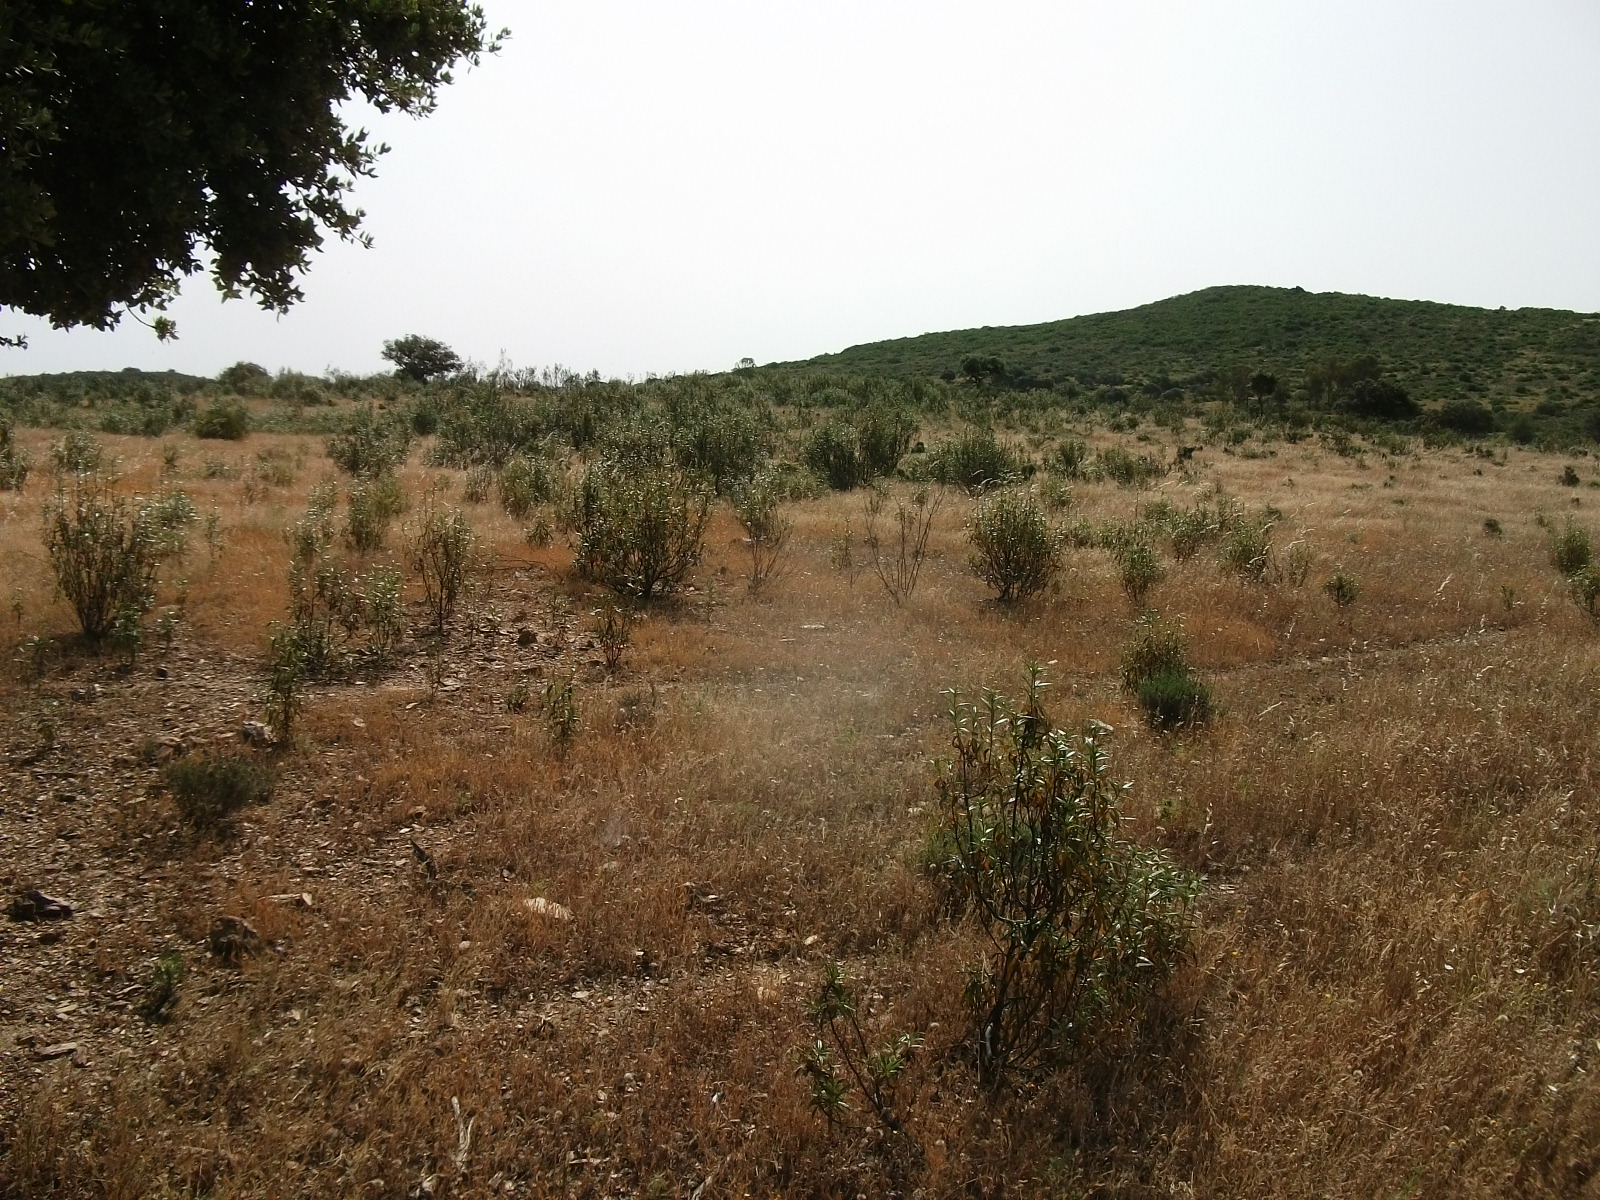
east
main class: Grassland
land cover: Grassland with sparse tree/shrub cover
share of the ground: > 75 %
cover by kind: herbaceous plants 90 %, broadleaved forest trees 5 %, shrubs 5 %
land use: Agriculture (excluding fallow land and kitchen gardens)
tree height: < 5 m
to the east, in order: Grassland with sparse tree/shrub cover; Shrubland without tree cover; Fences; Shruby margins; Abandoned hedges; Oats; Fences; Triticale
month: May
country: ES
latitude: 37.7492
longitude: -7.0399
